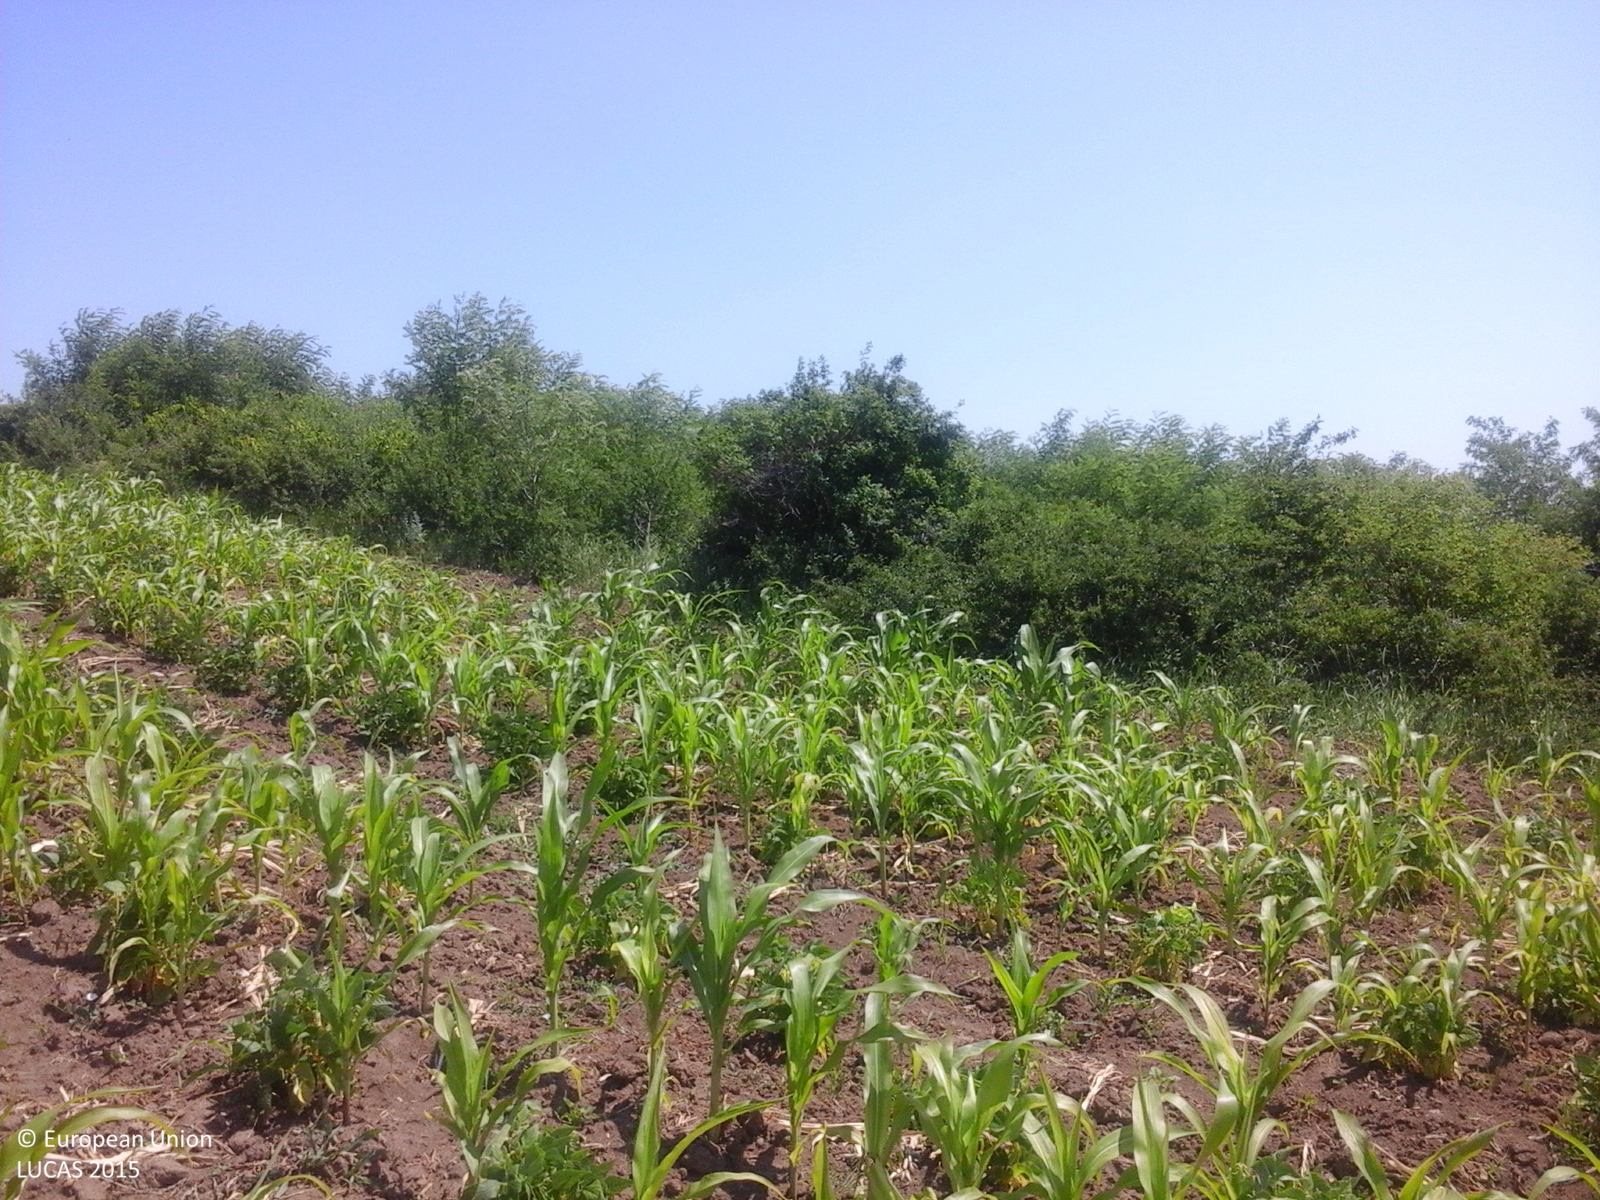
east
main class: Cropland
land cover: Maize
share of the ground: 50 - 75 %
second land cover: Other fresh vegetables
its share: < 10 %
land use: Agriculture (excluding fallow land and kitchen gardens)
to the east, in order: Maize; Other fresh vegetables; Shrubland with sparse tree cover; Grassland with sparse tree/shrub cover; Lucerne; Tracks; Lines of trees; Maize; Vineyards; Lines of trees; Tracks; Common wheat; Lucerne; Grassland without tree/shrub cover; Lucerne; Maize
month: June
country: RO
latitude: 46.7646
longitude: 27.4339
